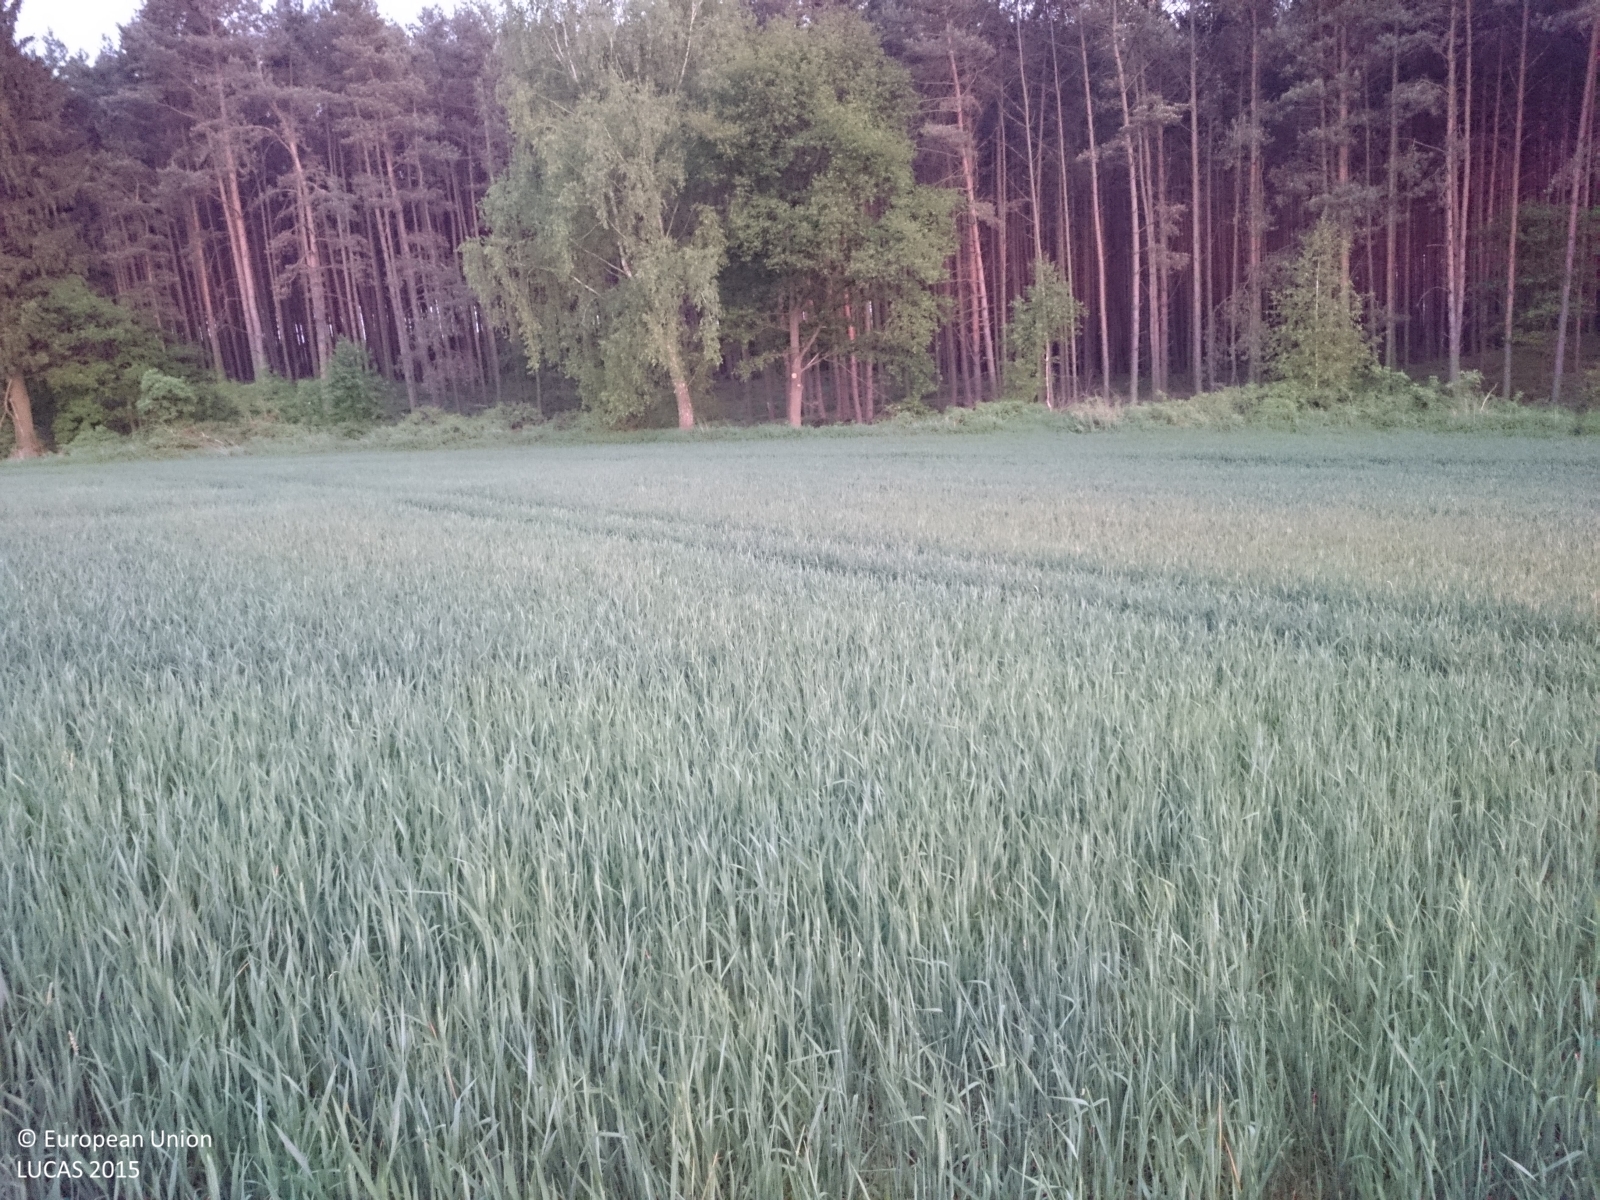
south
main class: Cropland
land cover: Barley
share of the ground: > 75 %
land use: Agriculture (excluding fallow land and kitchen gardens)
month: May
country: PL
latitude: 52.5671
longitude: 15.6549
